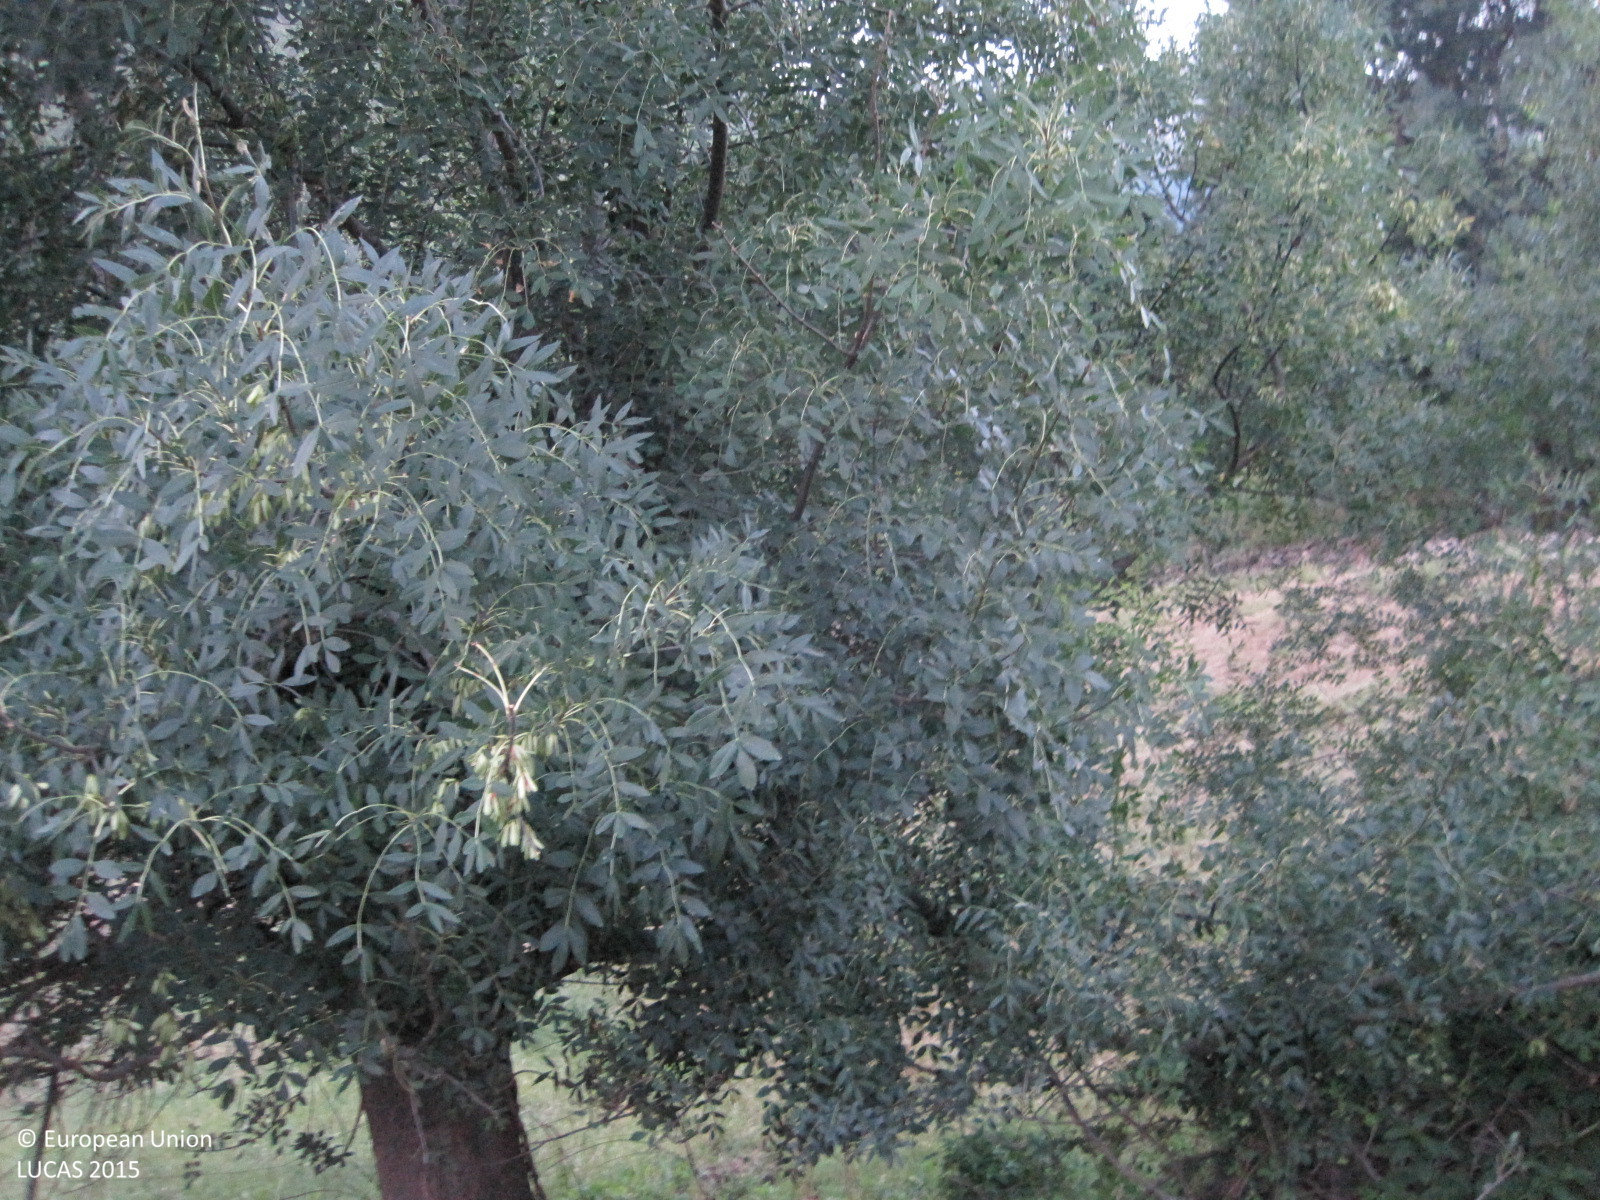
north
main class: Grassland
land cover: Grassland with sparse tree/shrub cover
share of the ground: > 75 %
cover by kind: herbaceous plants 95 %, broadleaved forest trees 5 %
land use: Agriculture (excluding fallow land and kitchen gardens)
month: July
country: ES
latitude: 40.2885
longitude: -4.8386
